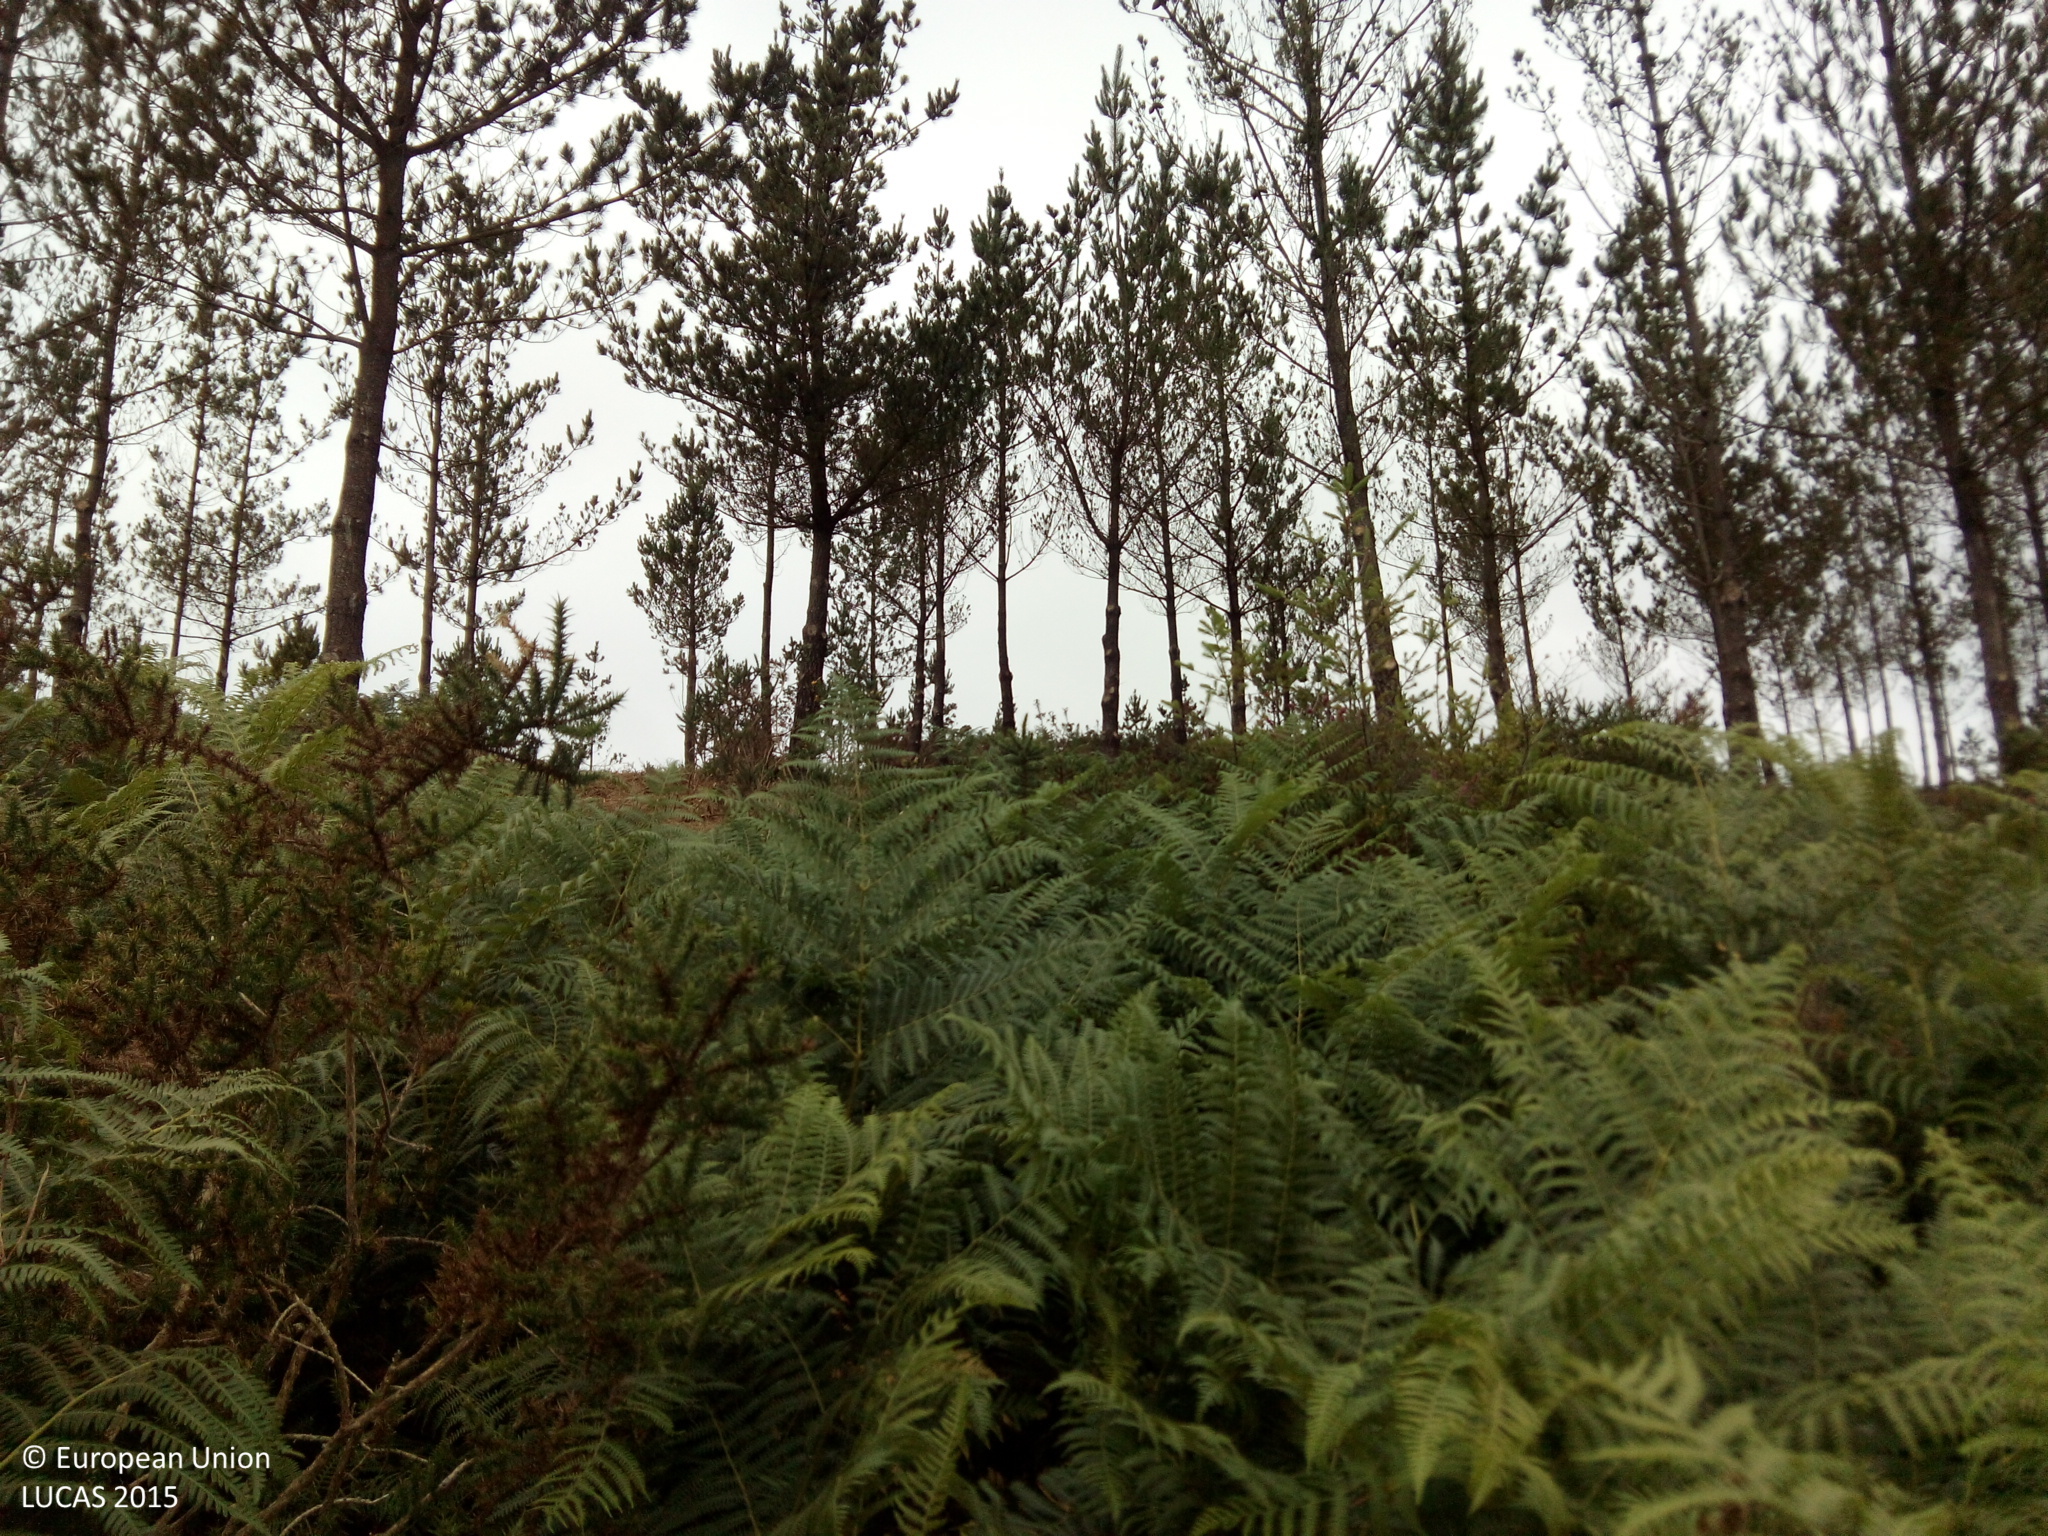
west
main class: Woodland
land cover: Spruce dominated coniferous woodland
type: exotic forest
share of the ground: > 75 %
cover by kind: shrubs 70 %, coniferous forest trees 30 %
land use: Forestry
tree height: < 5 m
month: July
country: ES
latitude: 42.5797
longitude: -8.3839
